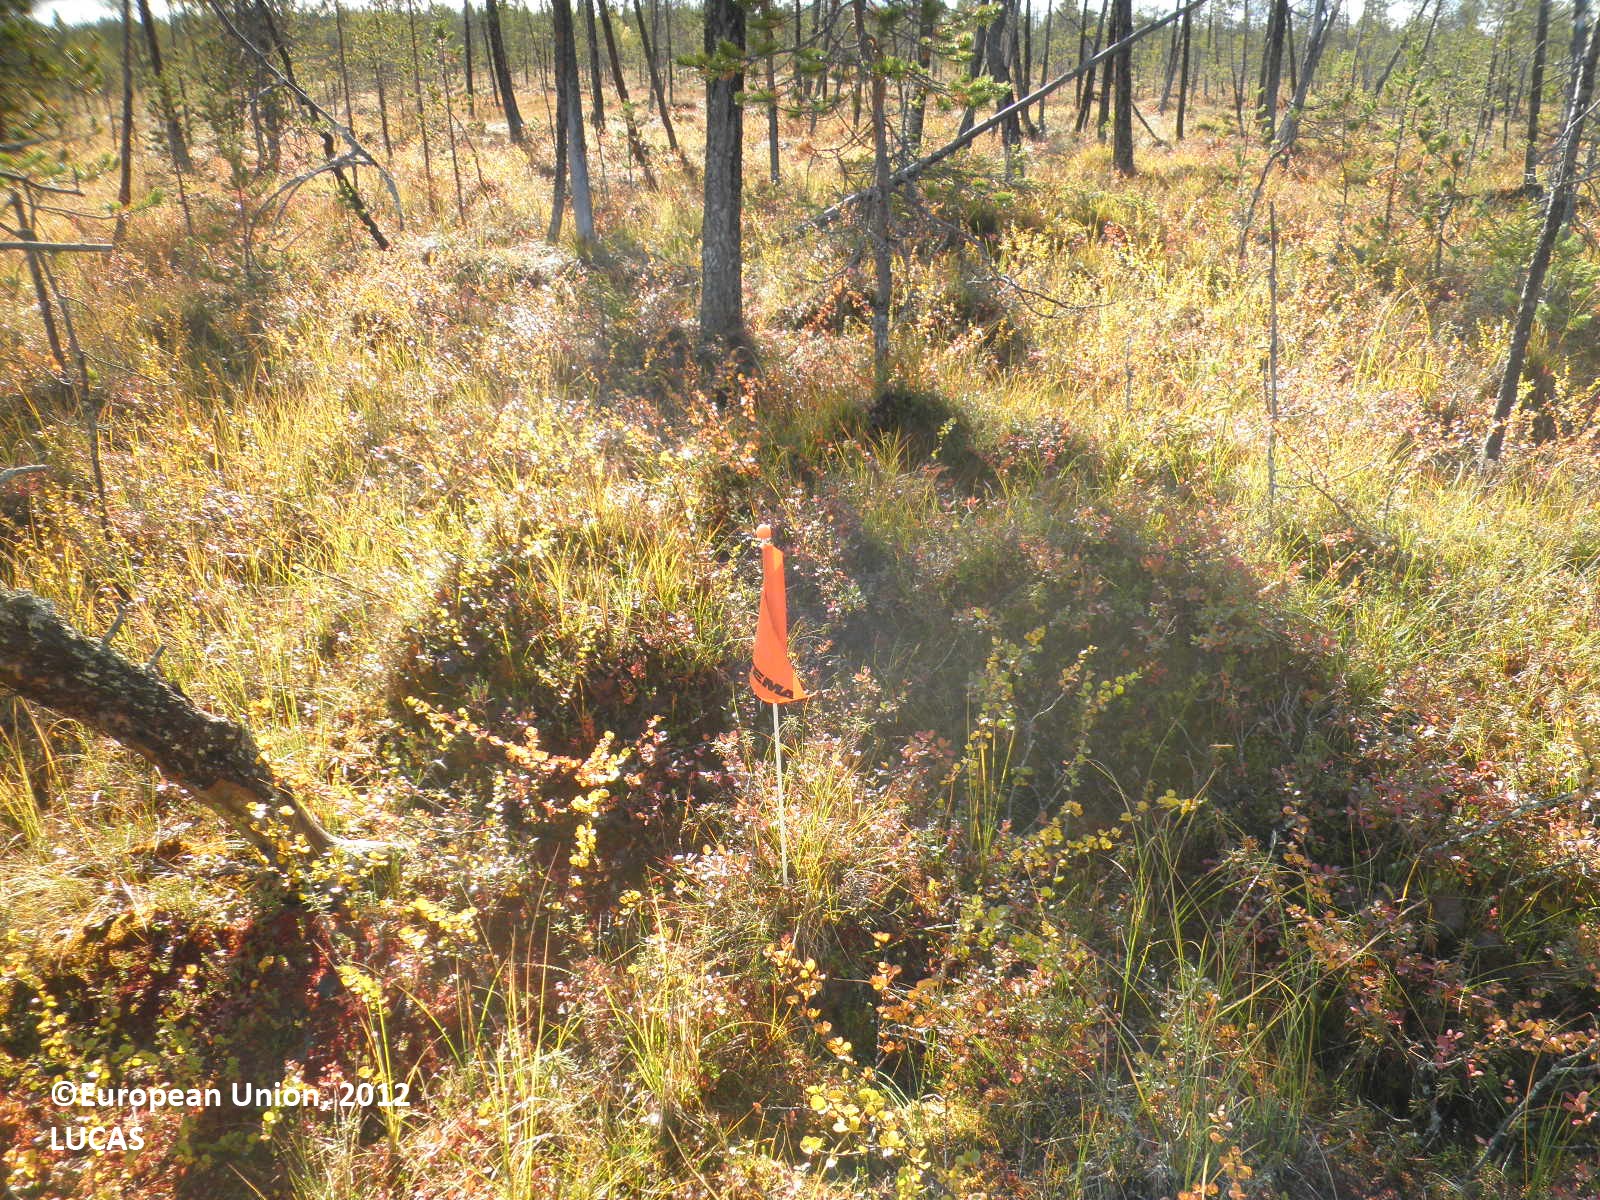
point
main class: Woodland
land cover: Pine dominated coniferous woodland
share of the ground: 10 - 25 %
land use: Forestry
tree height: > 5 m
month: September
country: FI
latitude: 67.4527
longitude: 28.4738
